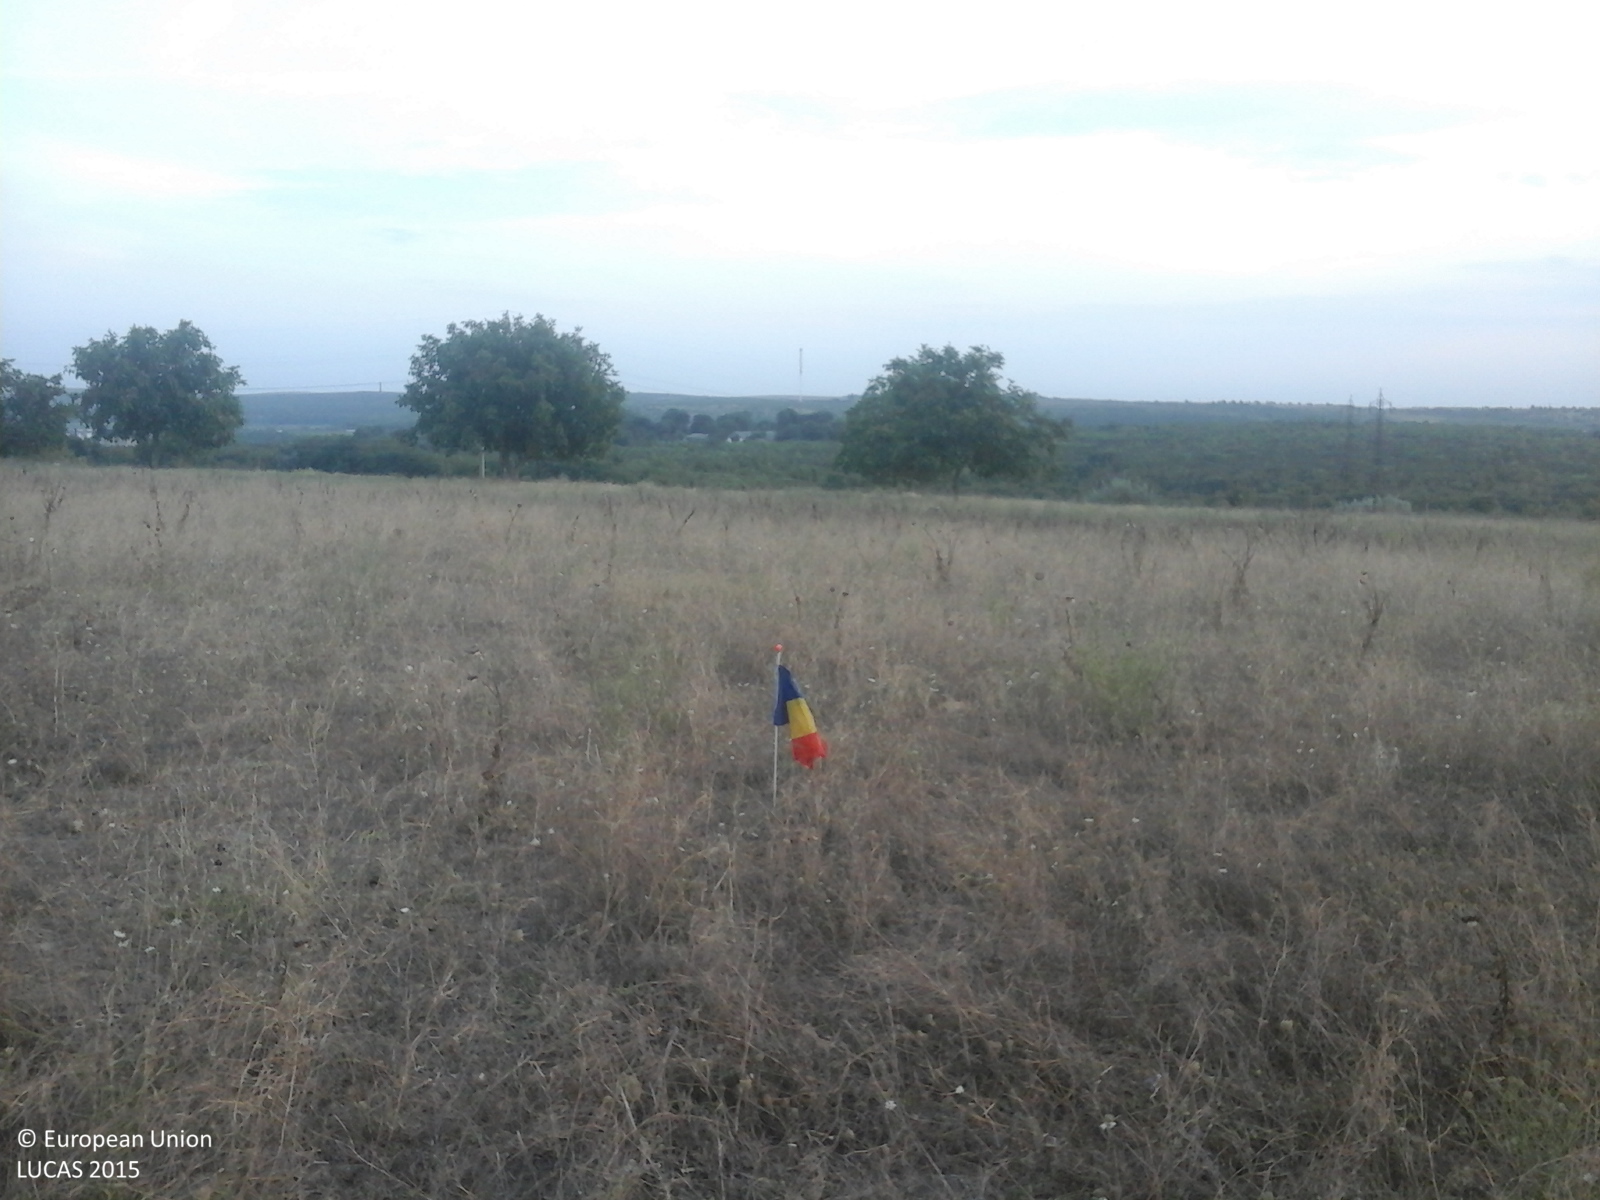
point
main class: Grassland
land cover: Spontaneously vegetated surfaces
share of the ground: > 75 %
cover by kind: herbaceous plants 100 %
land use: Agriculture (excluding fallow land and kitchen gardens)
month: August
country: RO
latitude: 44.3370
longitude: 28.0552
